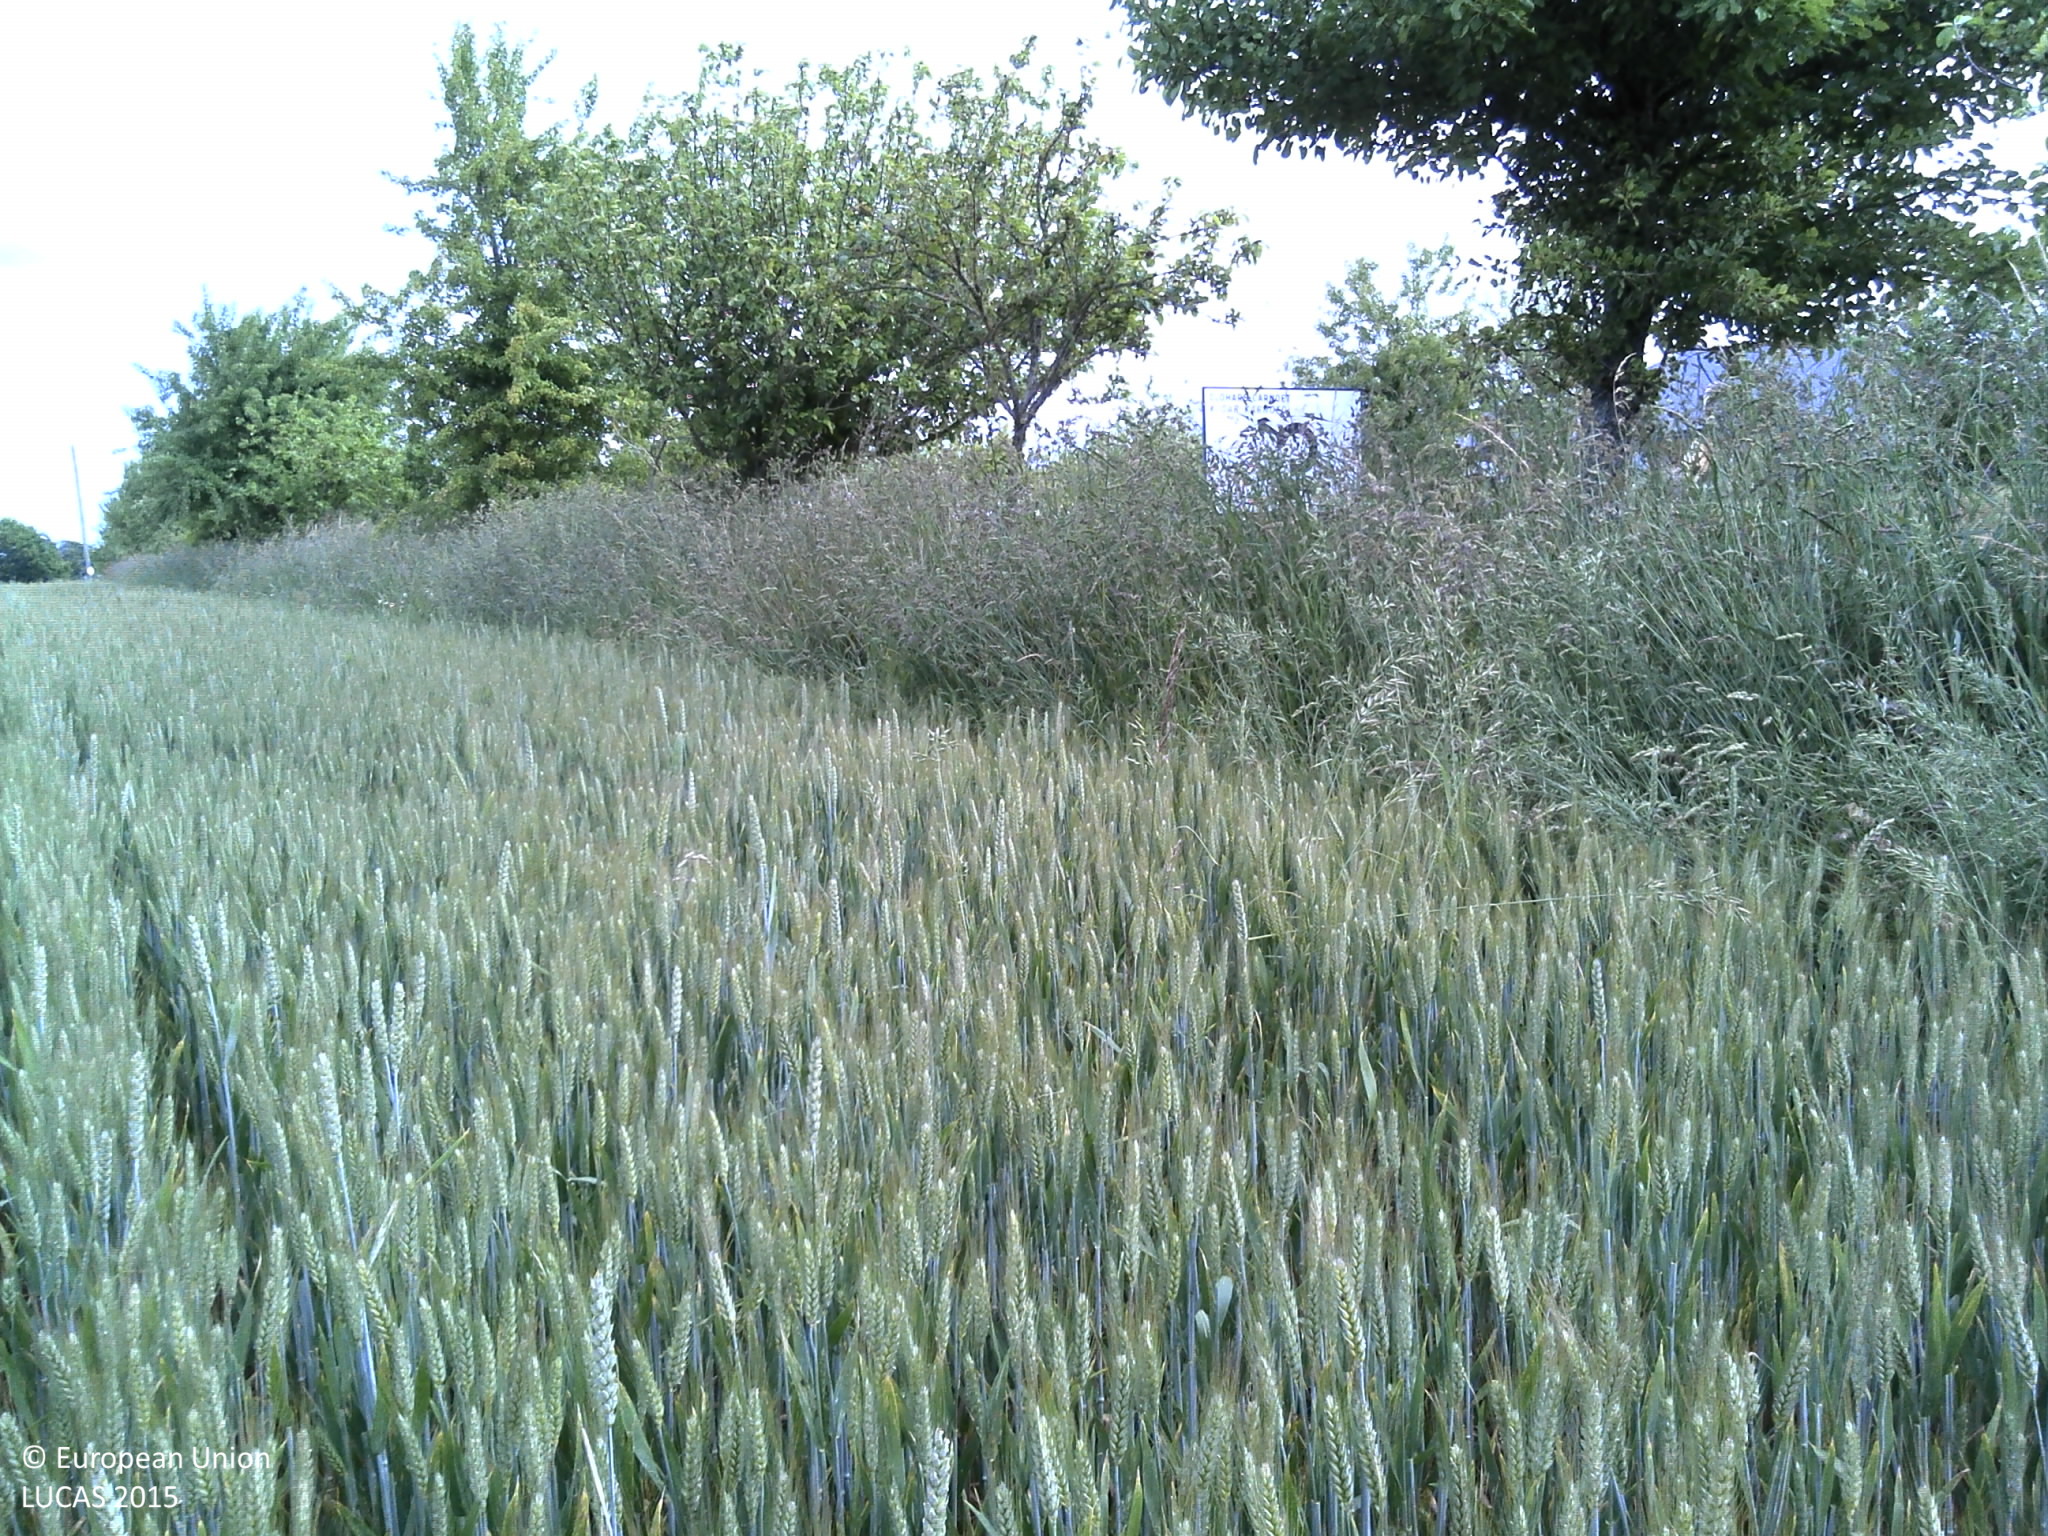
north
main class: Cropland
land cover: Common wheat
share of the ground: > 75 %
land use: Agriculture (excluding fallow land and kitchen gardens)
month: June
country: FR
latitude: 47.7810
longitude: -3.5699
